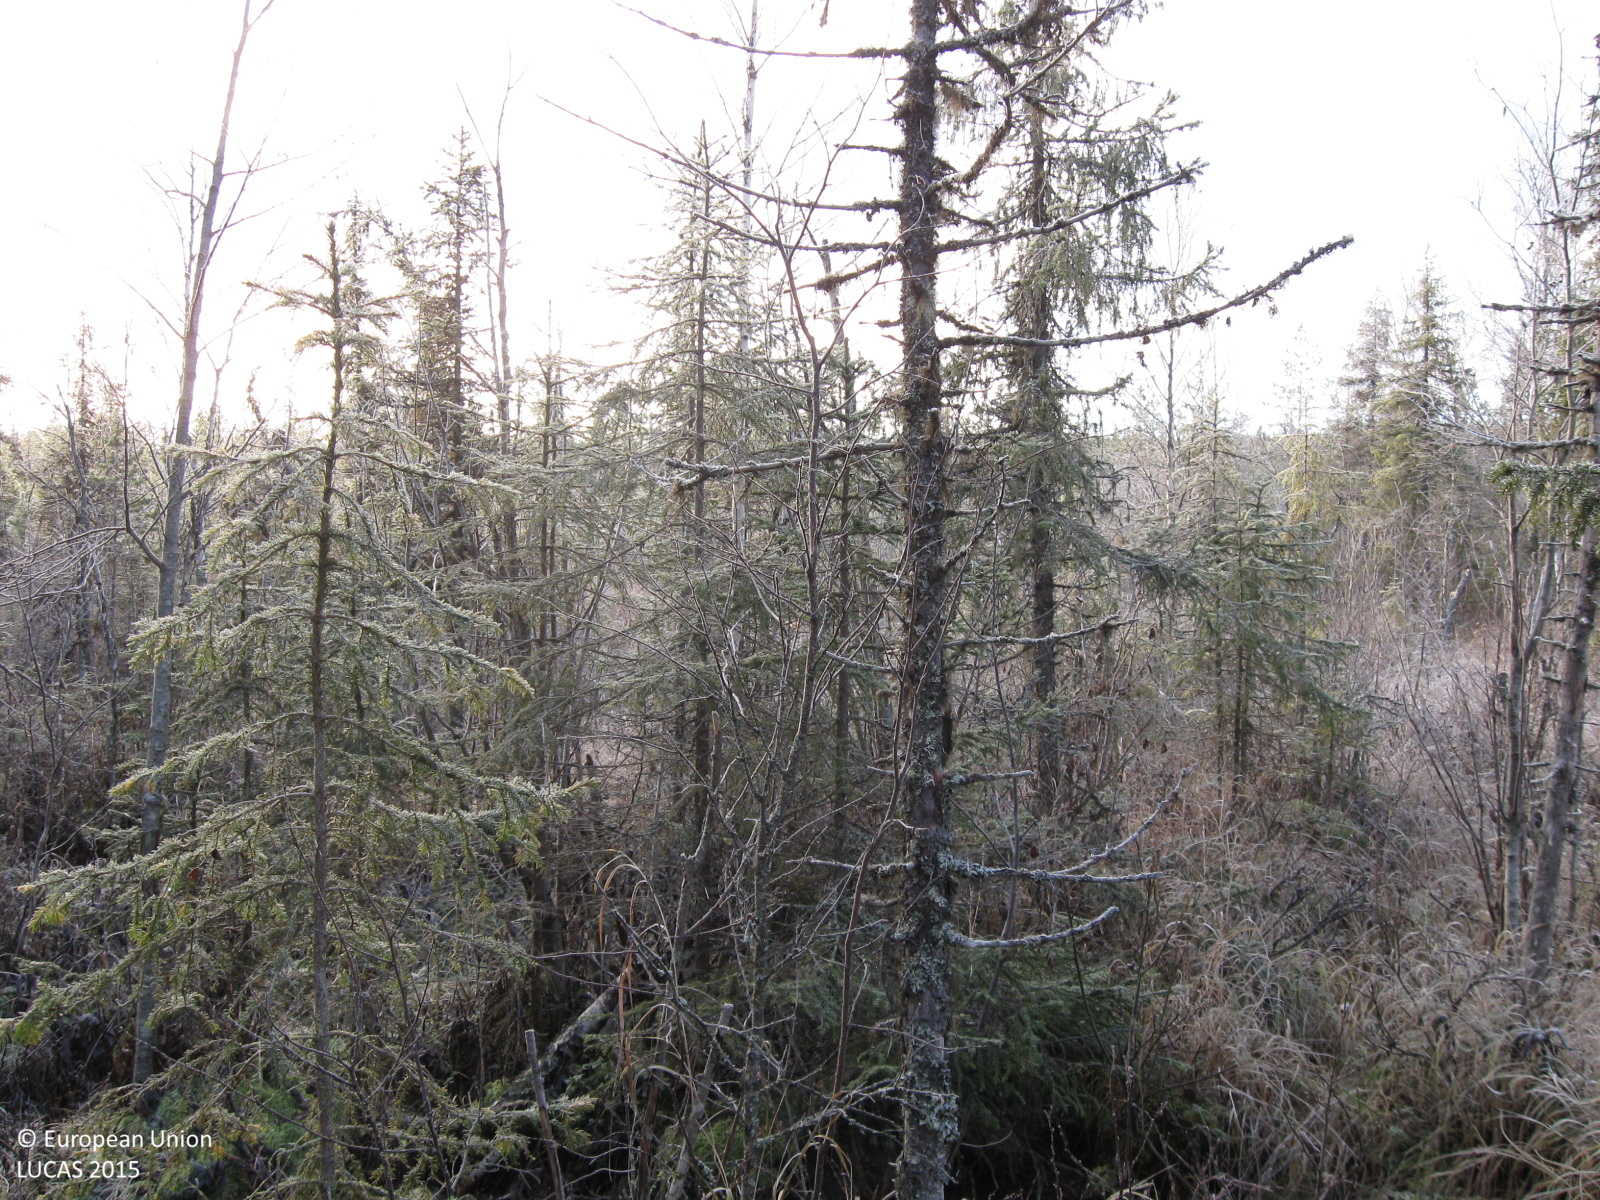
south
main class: Woodland
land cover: Spruce dominated mixed woodland
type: mire and swamp forests
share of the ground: > 75 %
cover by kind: broadleaved forest trees 50 %, coniferous forest trees 25 %, herbaceous plants 20 %, shrubs 5 %
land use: Semi-natural and natural areas not in use
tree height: > 5 m
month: October
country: SE
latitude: 66.0968
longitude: 21.5796
